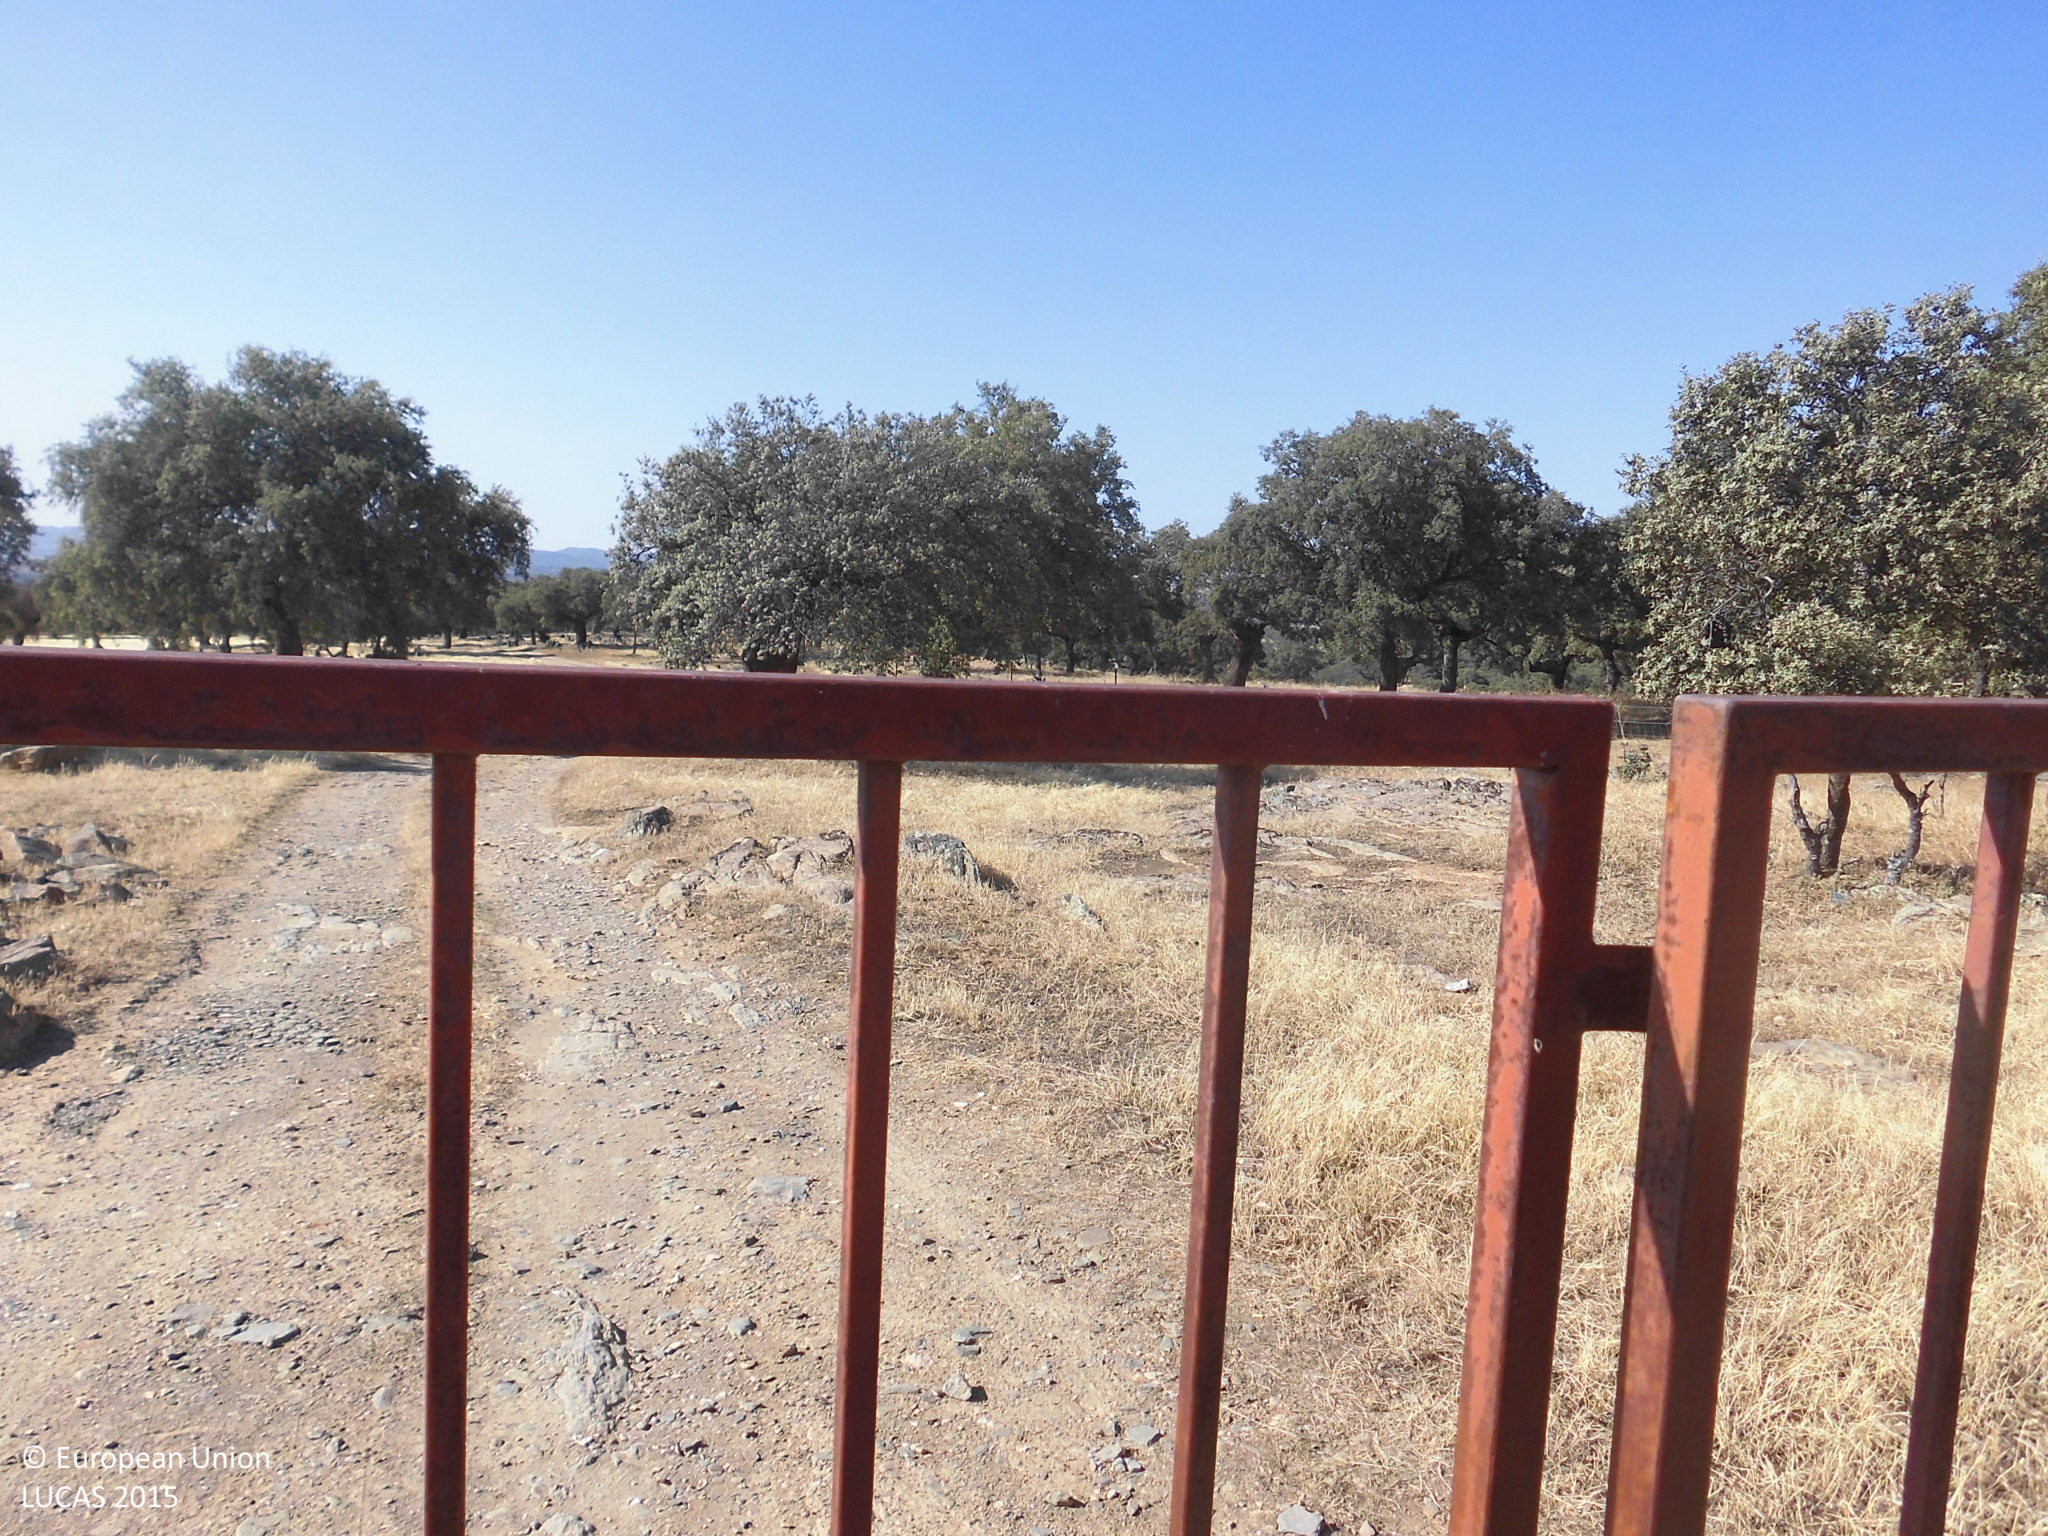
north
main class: Woodland
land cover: Broadleaved woodland
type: broadleaved evergreen forest
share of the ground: 10 - 25 %
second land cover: Grassland without tree/shrub cover
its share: > 75 %
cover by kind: herbaceous plants 80 %, broadleaved forest trees 20 %
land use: Forestry
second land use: Agriculture (excluding fallow land and kitchen gardens)
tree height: > 5 m
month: July
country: ES
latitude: 39.5636
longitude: -5.5934
